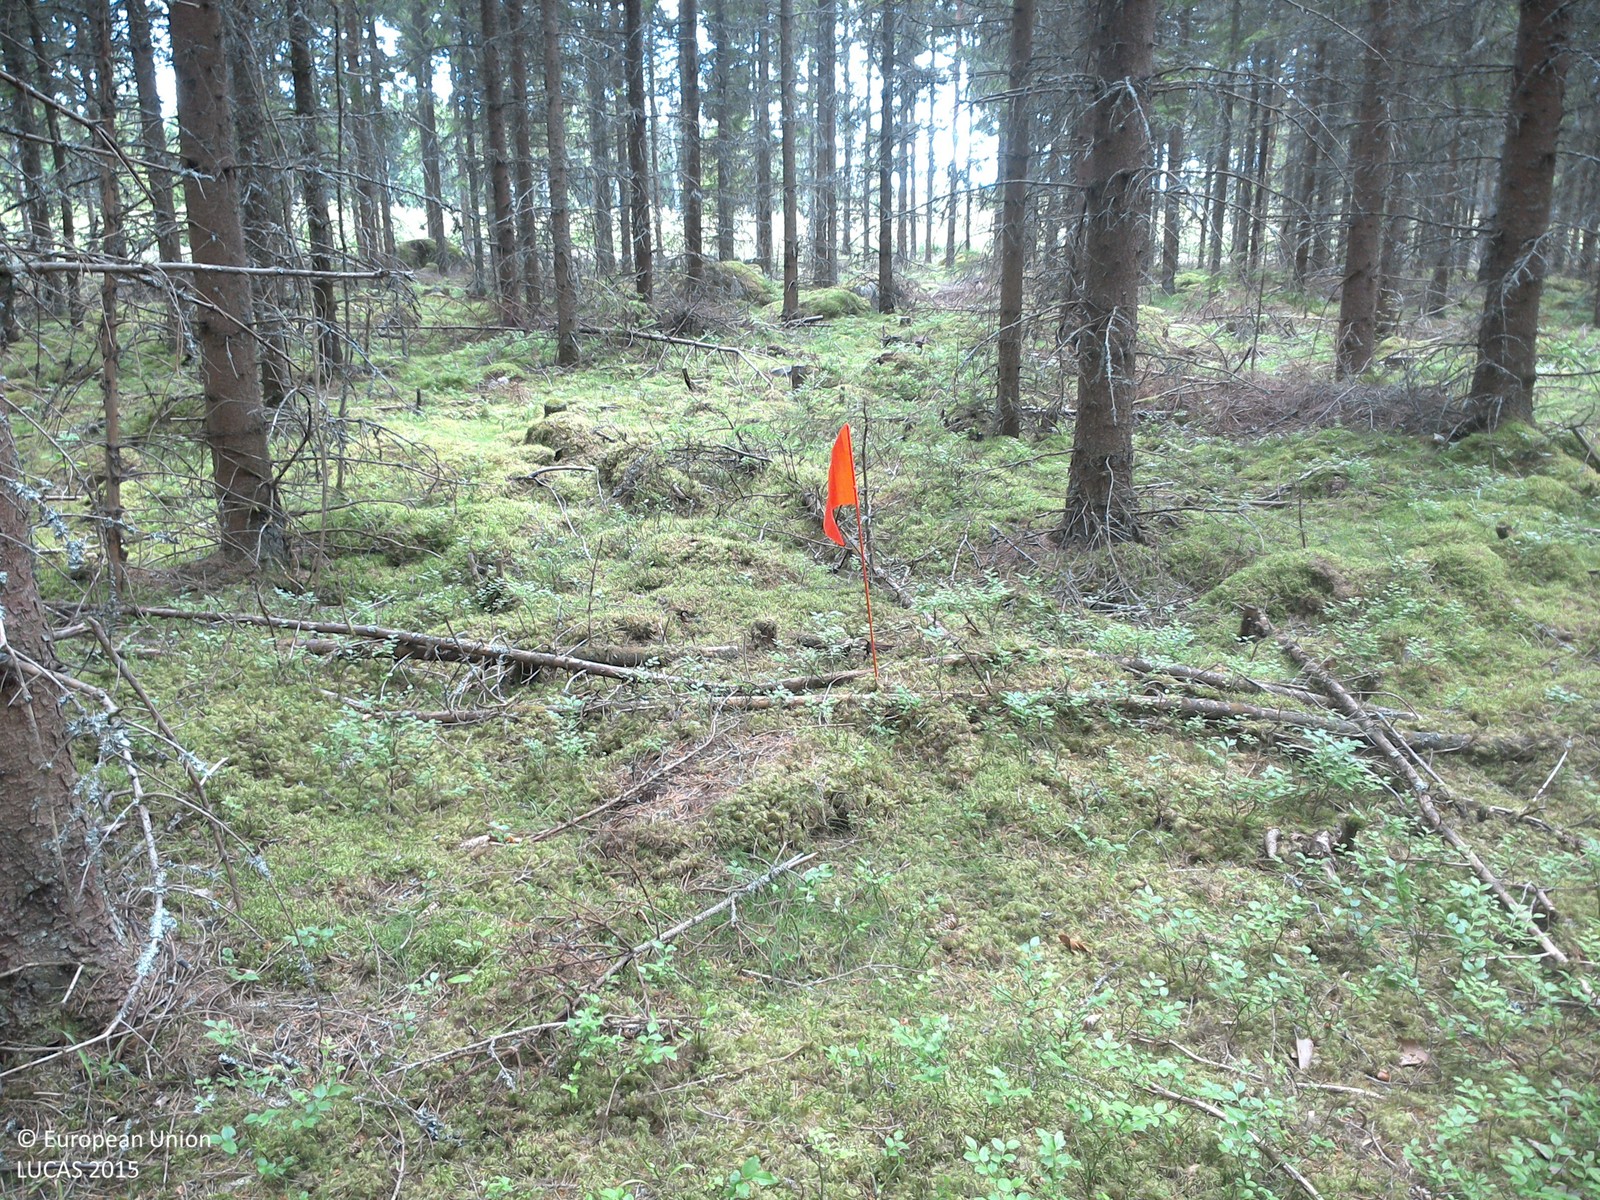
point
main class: Woodland
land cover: Spruce dominated coniferous woodland
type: boreal forest
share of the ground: 50 - 75 %
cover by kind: coniferous forest trees 60 %, lichens and mosses 35 %, shrubs 5 %
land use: Forestry
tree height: > 5 m
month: June
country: SE
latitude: 57.9610
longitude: 15.9625
